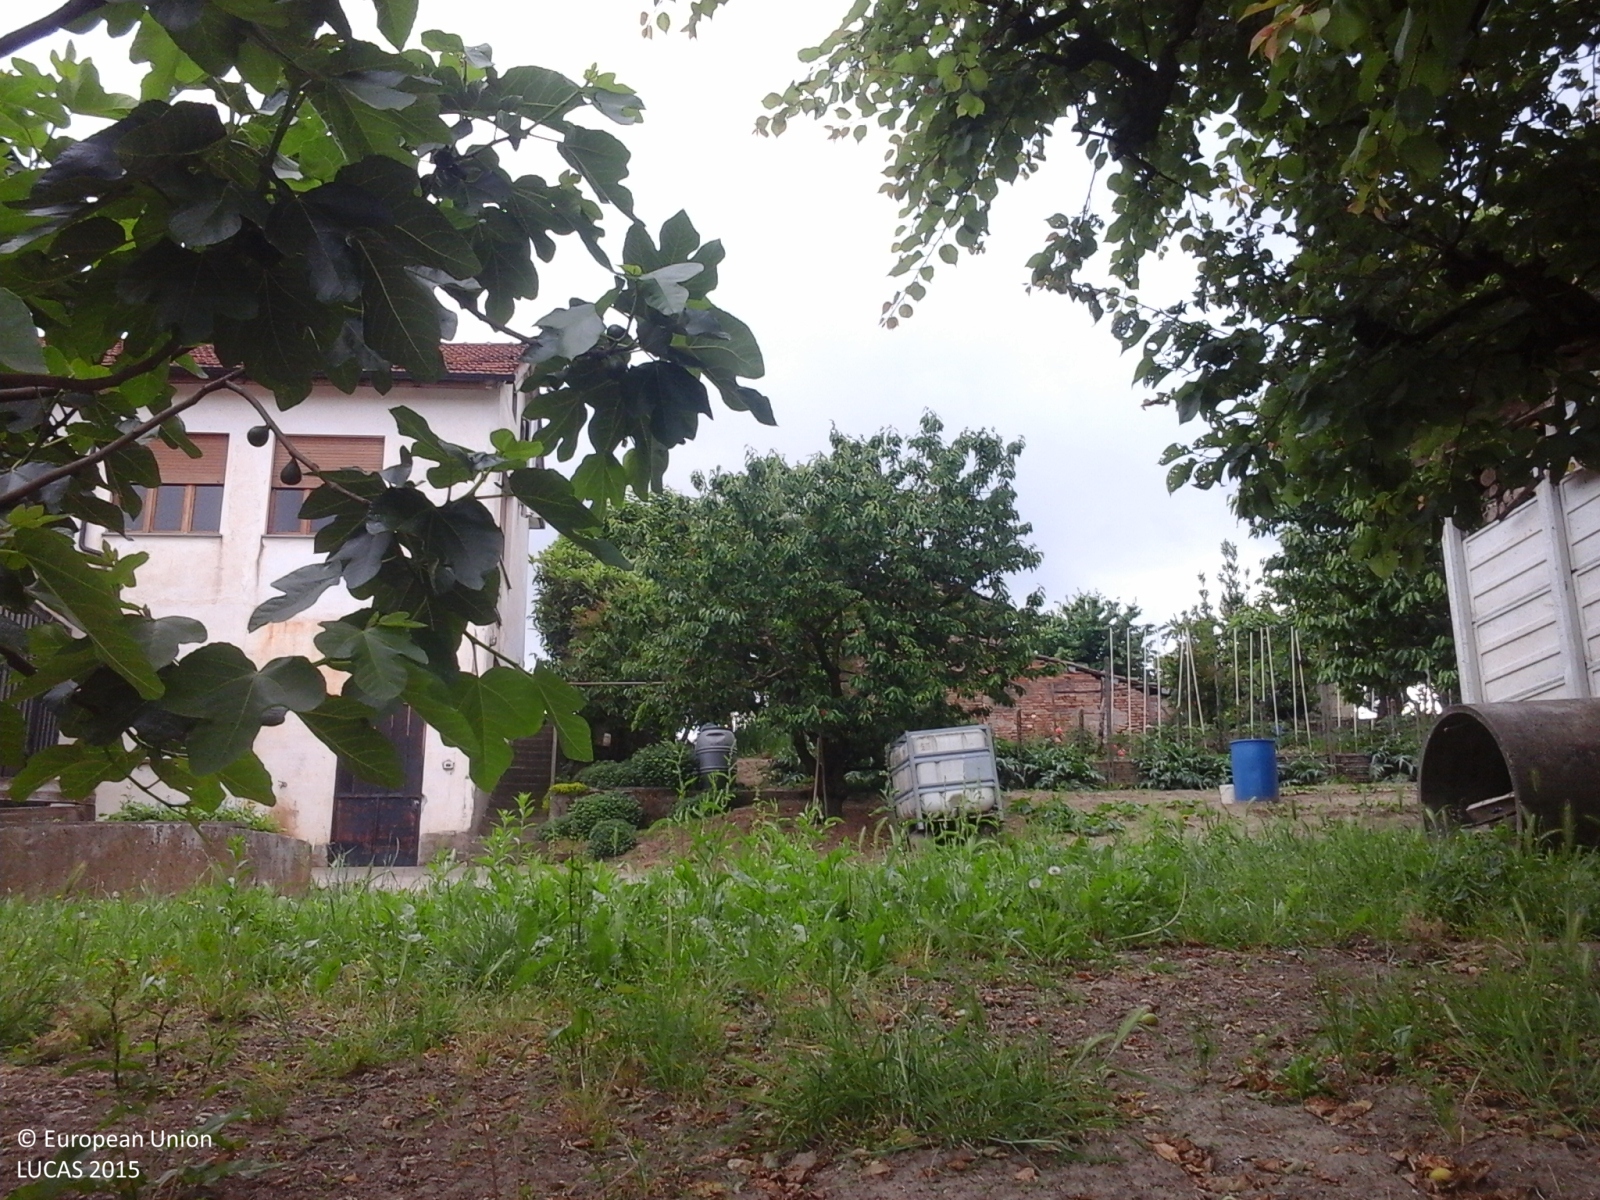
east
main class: Woodland
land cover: Broadleaved woodland
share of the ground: 25 - 50 %
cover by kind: broadleaved forest trees 50 %, herbaceous plants 50 %
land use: Residential
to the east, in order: Broadleaved woodland; Artificial constructions in urban areas; Grassland without tree/shrub cover; Tracks; Vineyards
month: May
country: IT
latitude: 44.7867
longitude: 8.2466
